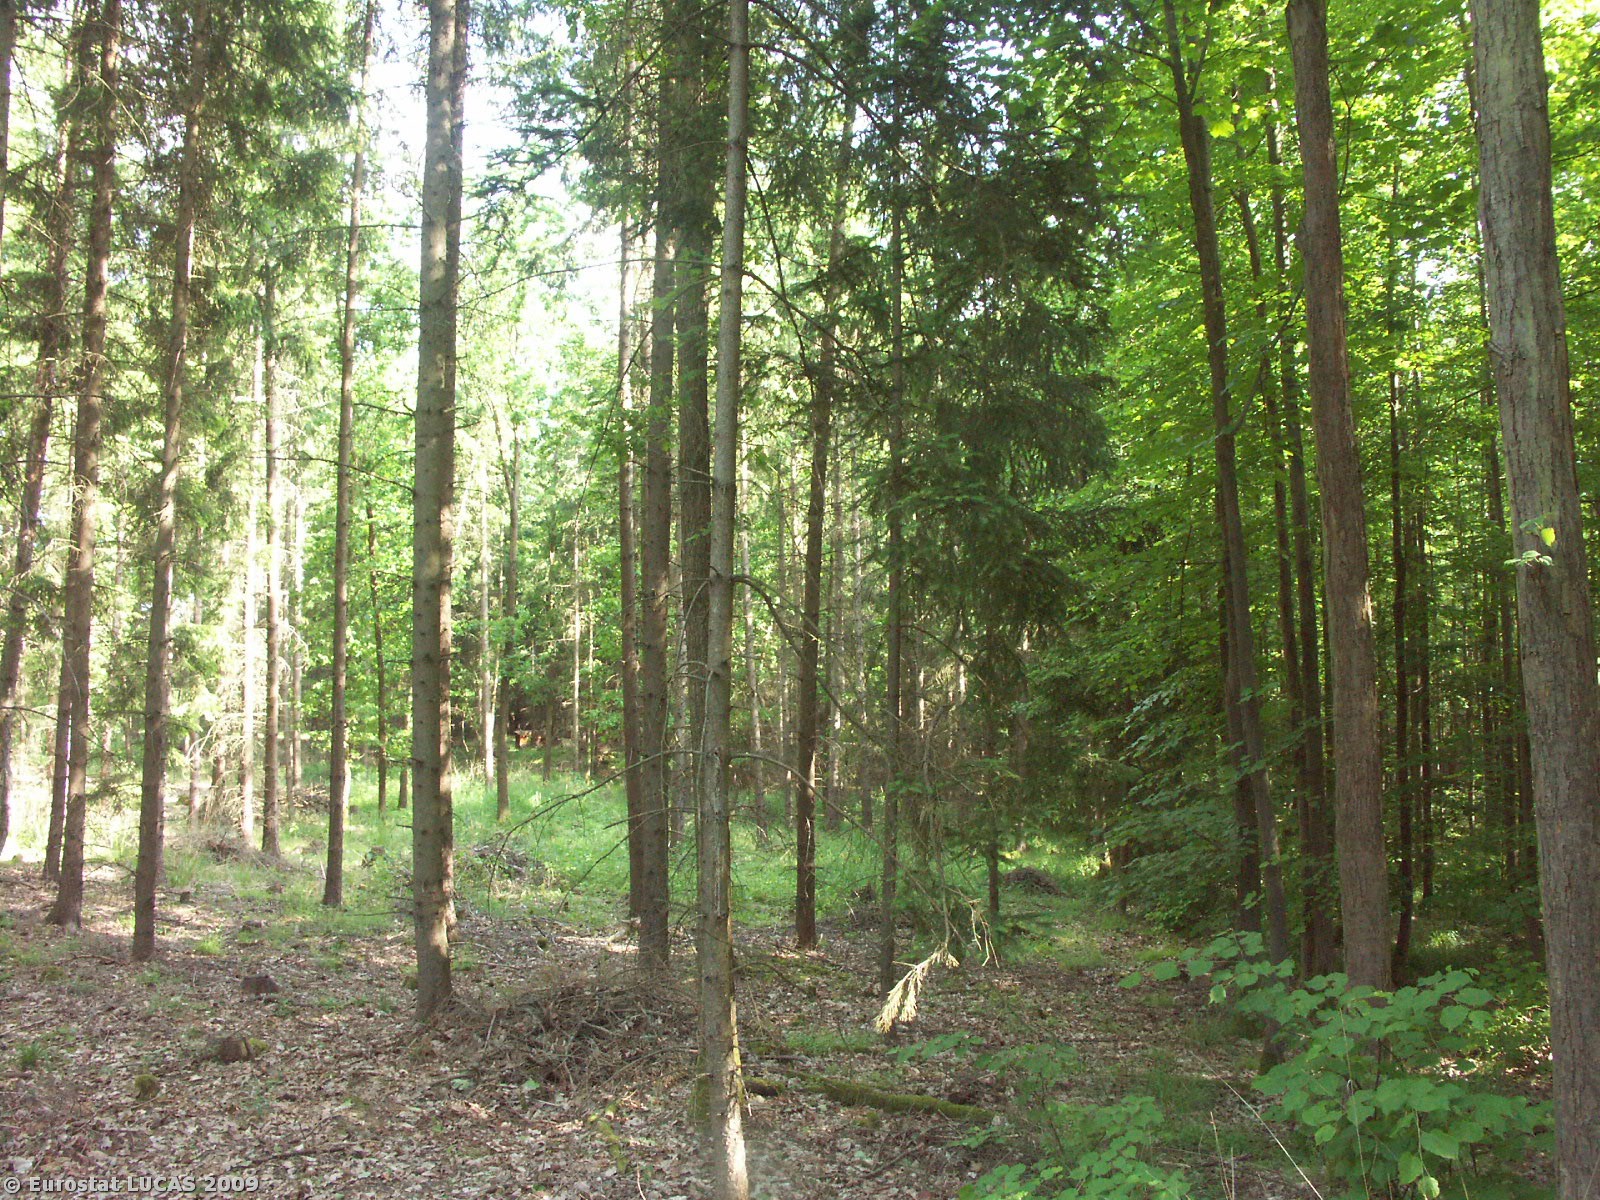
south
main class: Woodland
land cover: Mixed woodland
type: hemiboreal forest and nemoral coniferous forest and mixed broadleaved-coniferous forest
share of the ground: > 75 %
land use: Forestry
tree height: > 5 m
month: May
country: CZ
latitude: 49.0315
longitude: 14.5285
